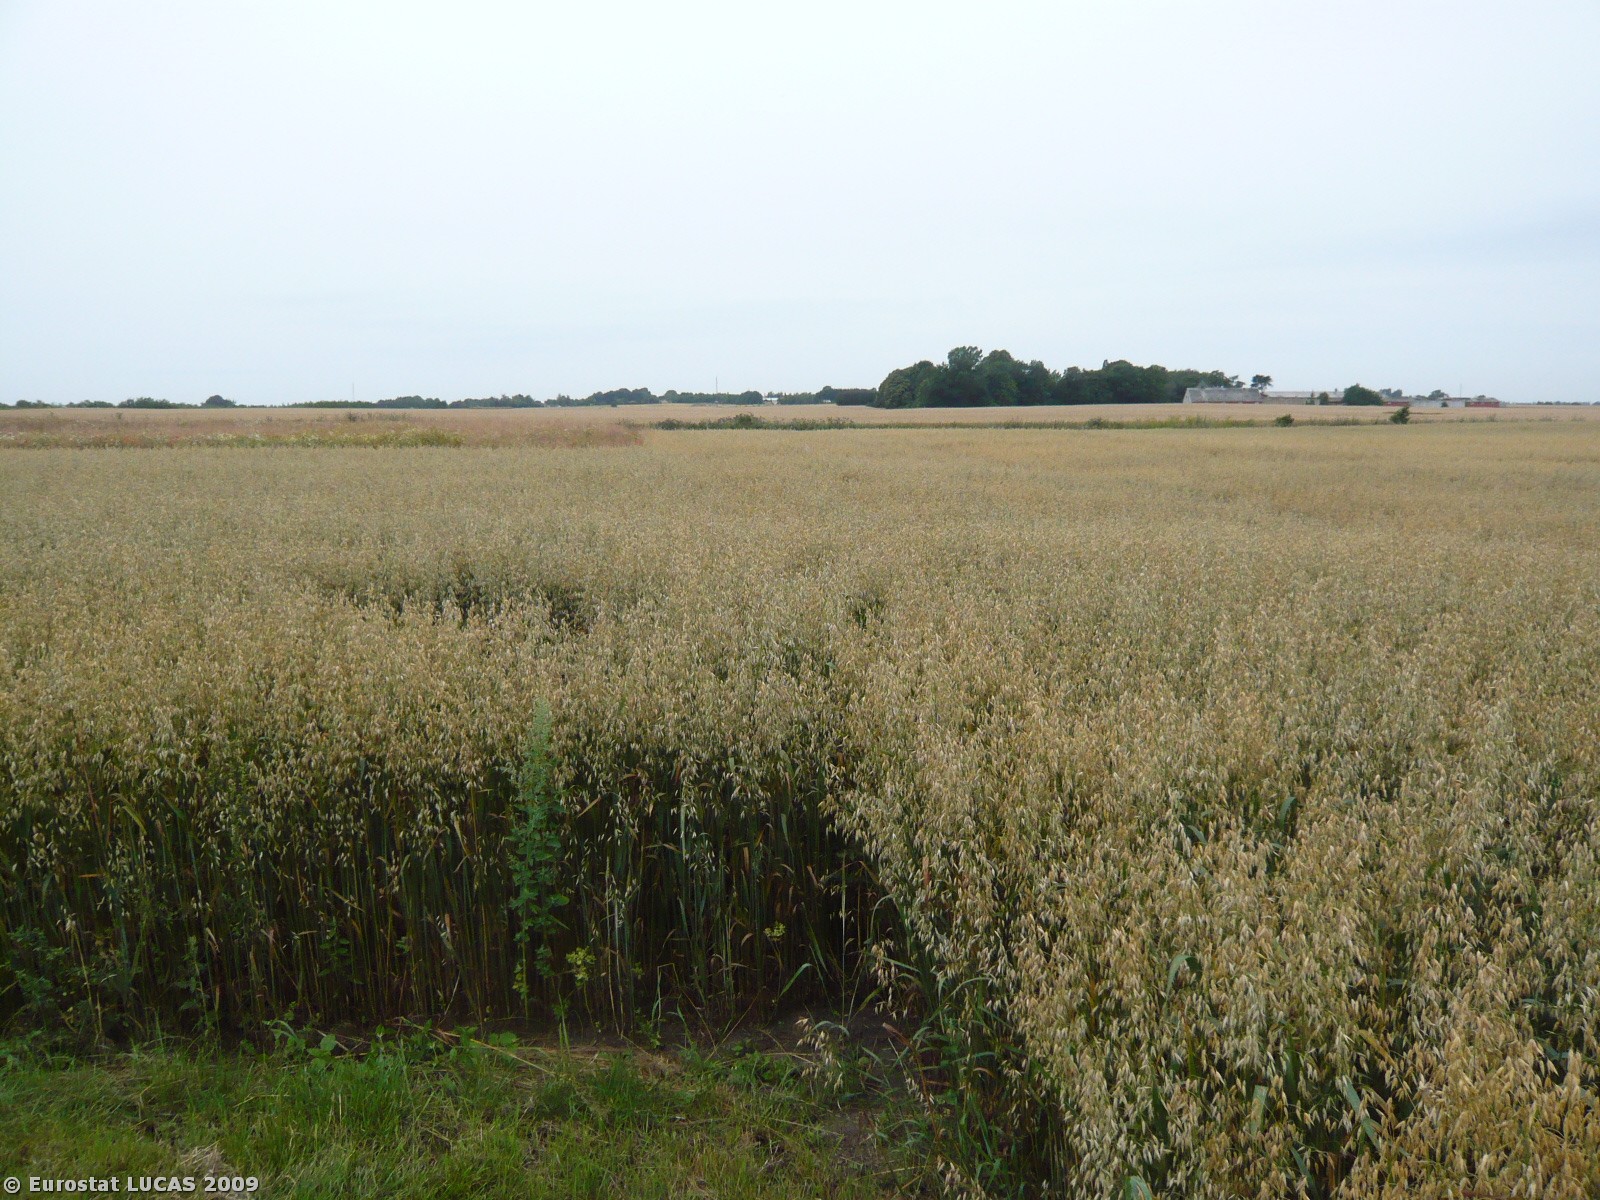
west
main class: Cropland
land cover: Oats
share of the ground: > 75 %
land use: Agriculture (excluding fallow land and kitchen gardens)
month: July
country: DK
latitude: 55.7377
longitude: 12.1801
